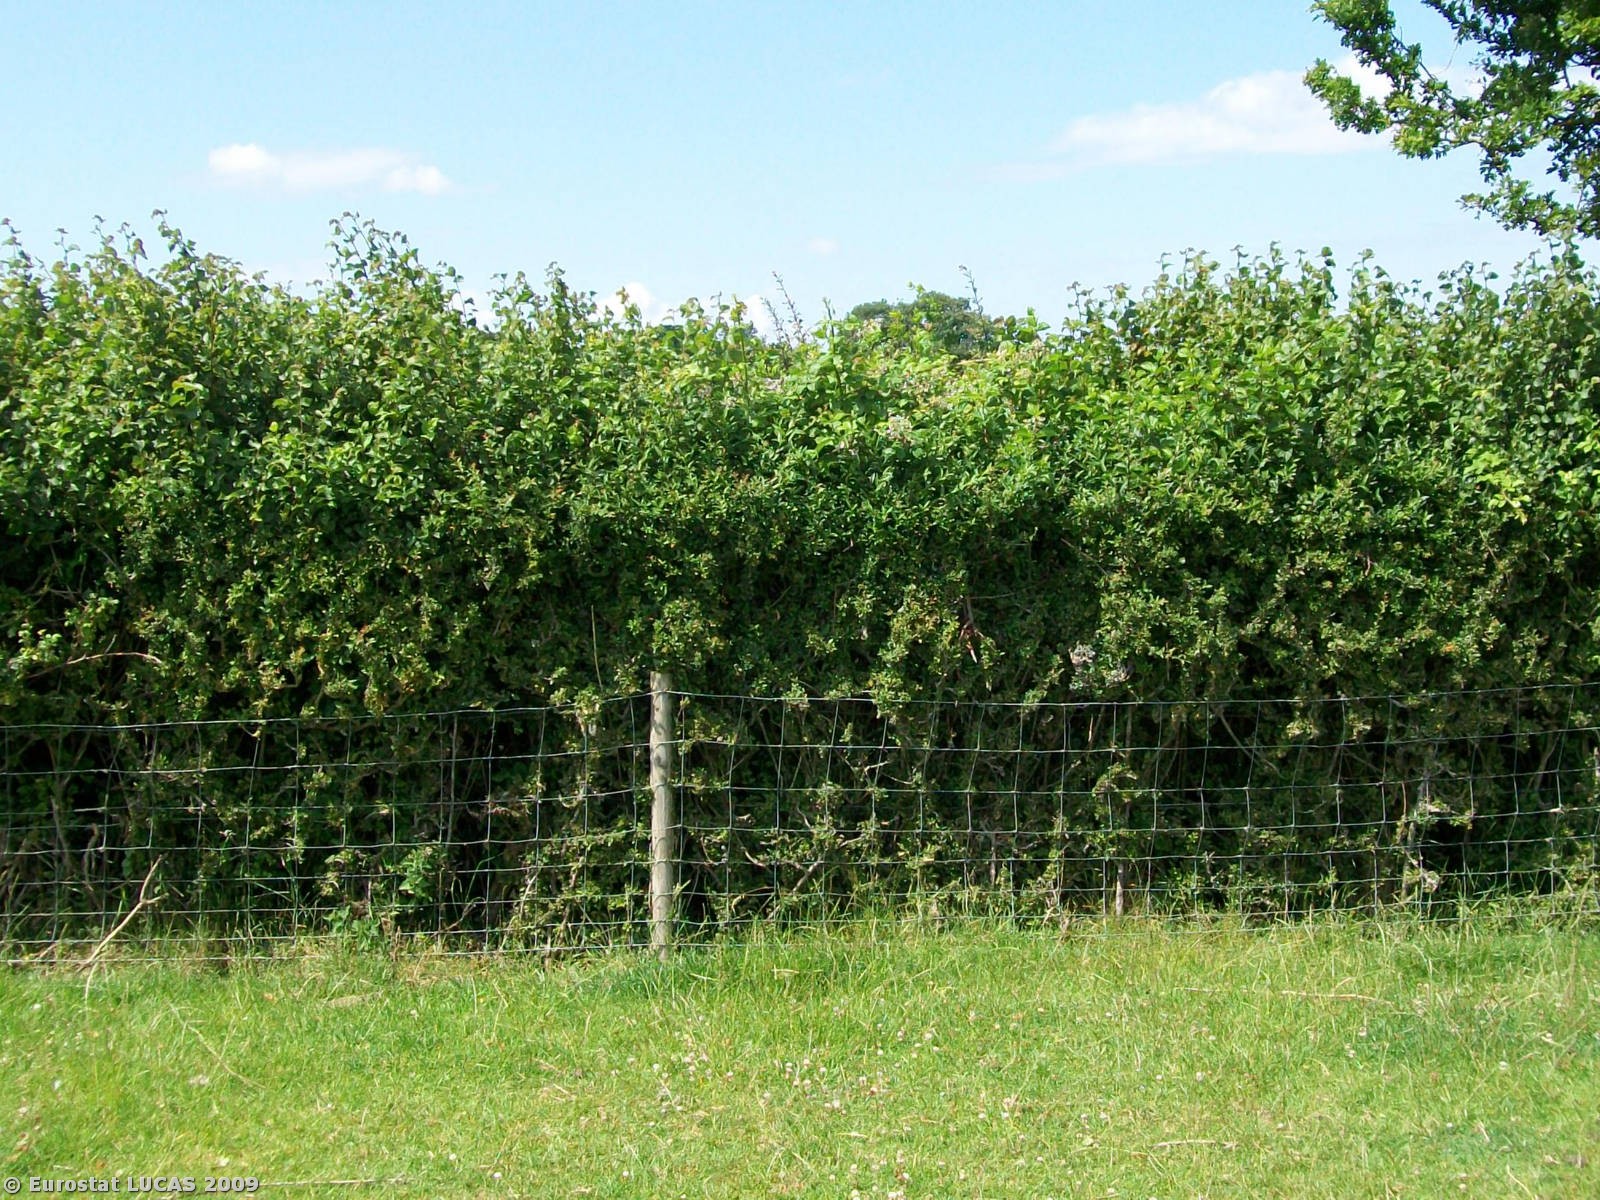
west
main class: Grassland
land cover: Grassland without tree/shrub cover
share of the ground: > 75 %
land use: Agriculture (excluding fallow land and kitchen gardens)
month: July
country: GB
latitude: 51.1195
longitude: -2.7717
